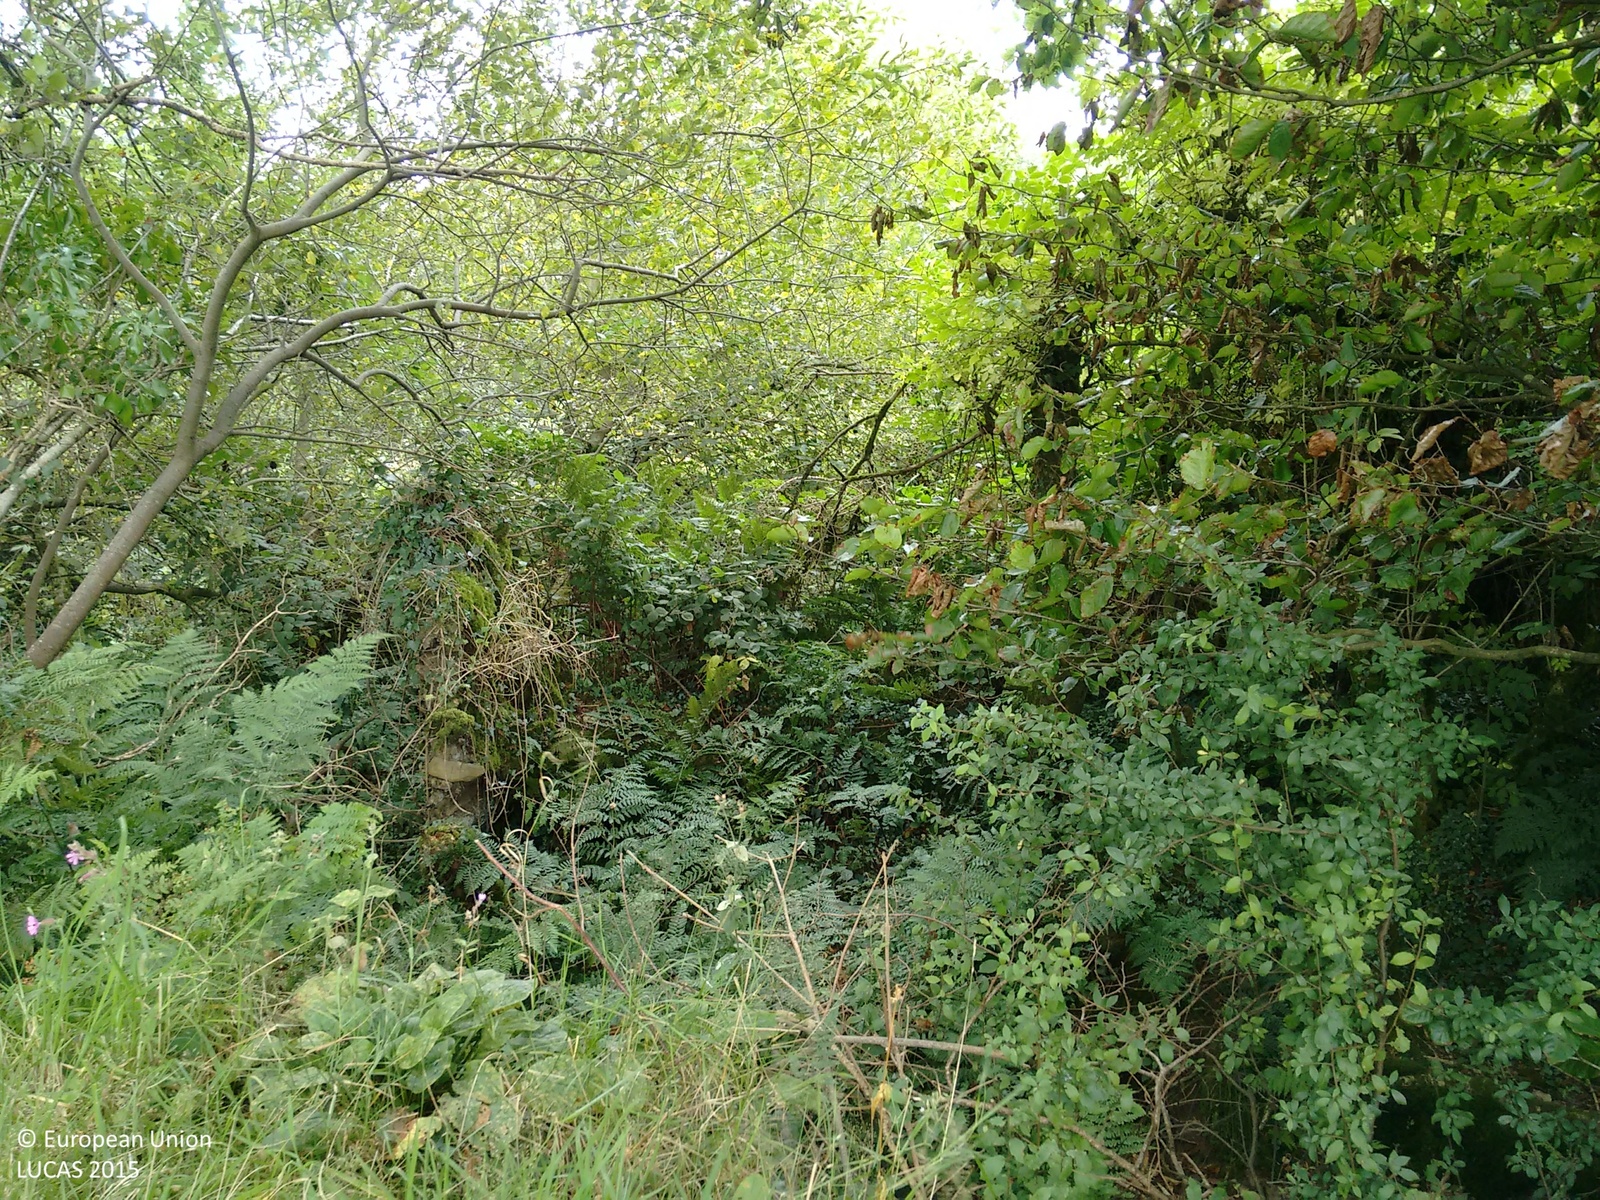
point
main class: Woodland
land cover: Broadleaved woodland
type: mesophytic deciduous forest
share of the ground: > 75 %
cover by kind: broadleaved forest trees 100 %
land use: Forestry
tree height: > 5 m
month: September
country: GB
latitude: 50.9546
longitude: -4.3226
